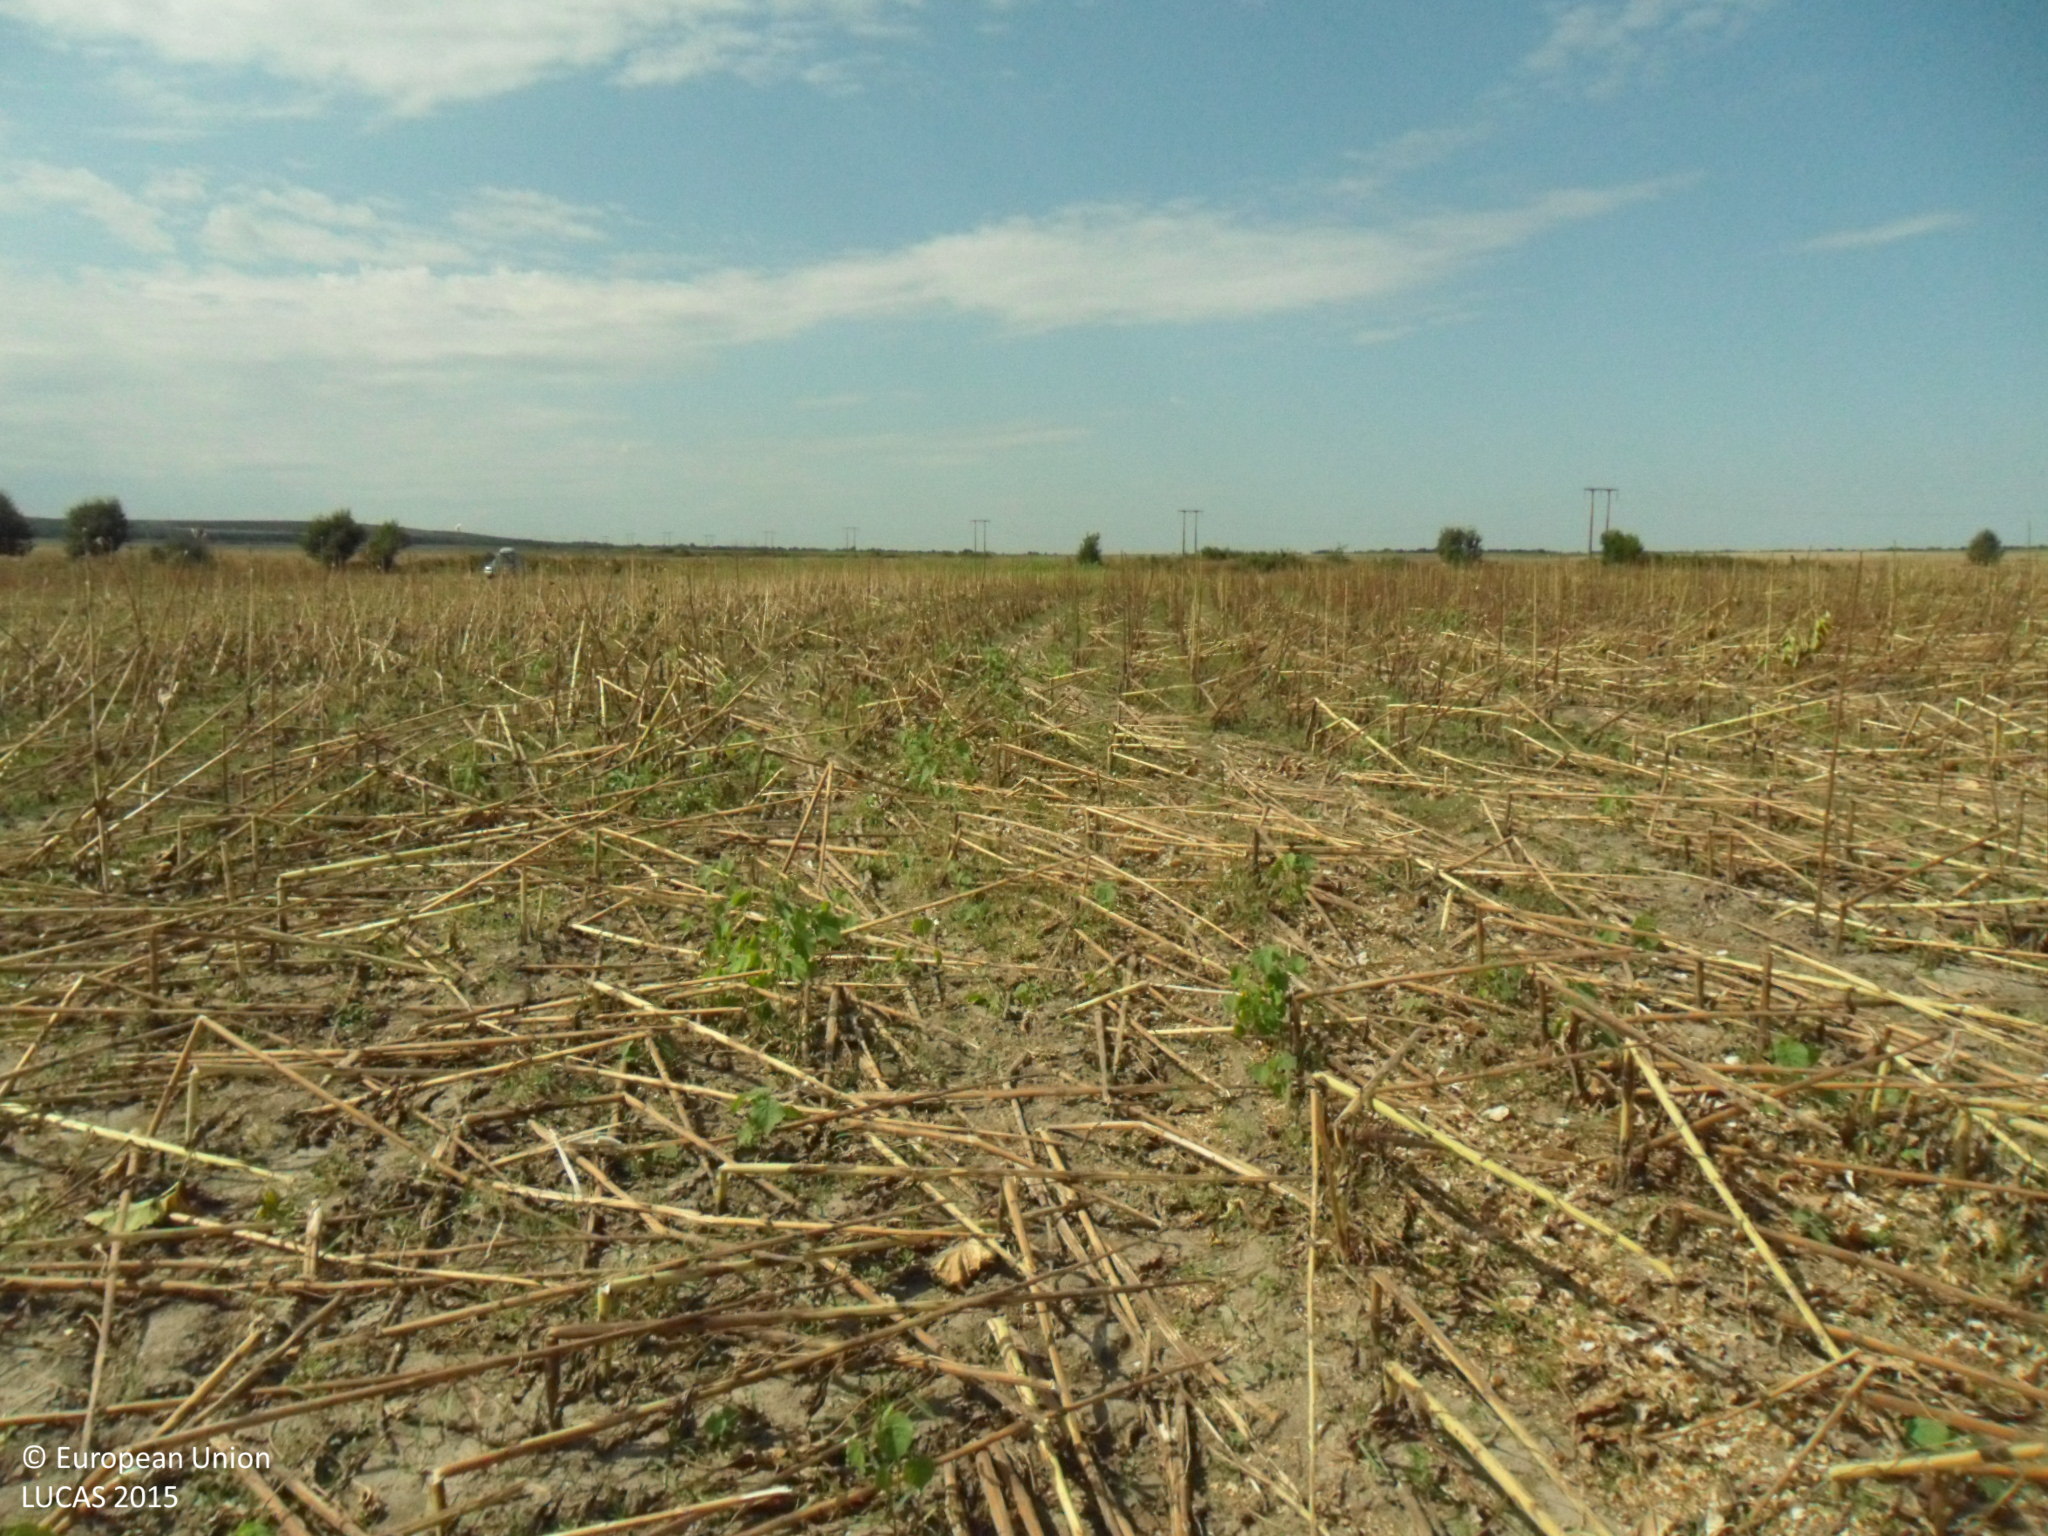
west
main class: Cropland
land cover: Sunflower
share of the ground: < 10 %
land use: Agriculture (excluding fallow land and kitchen gardens)
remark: Harvested field
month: September
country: BG
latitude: 43.9371
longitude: 26.3891
